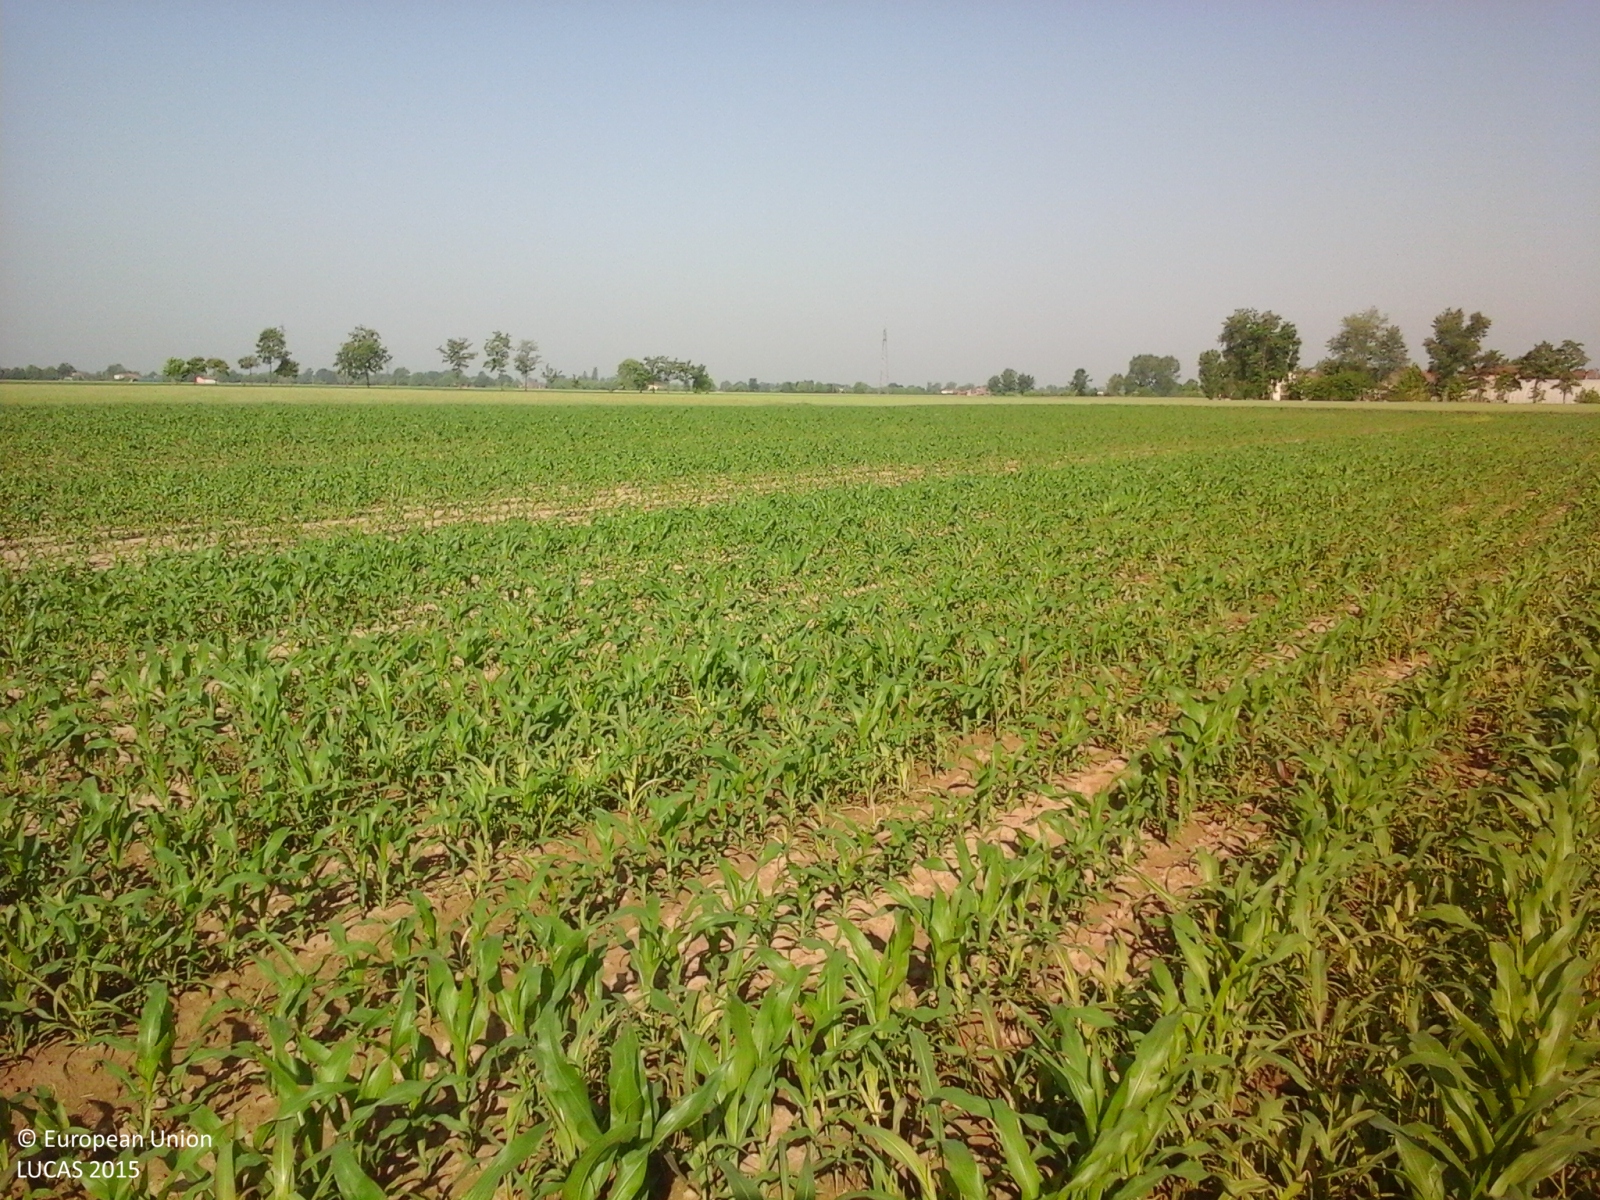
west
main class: Cropland
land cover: Maize
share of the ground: 25 - 50 %
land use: Agriculture (excluding fallow land and kitchen gardens)
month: May
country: IT
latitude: 45.1240
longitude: 10.6218
